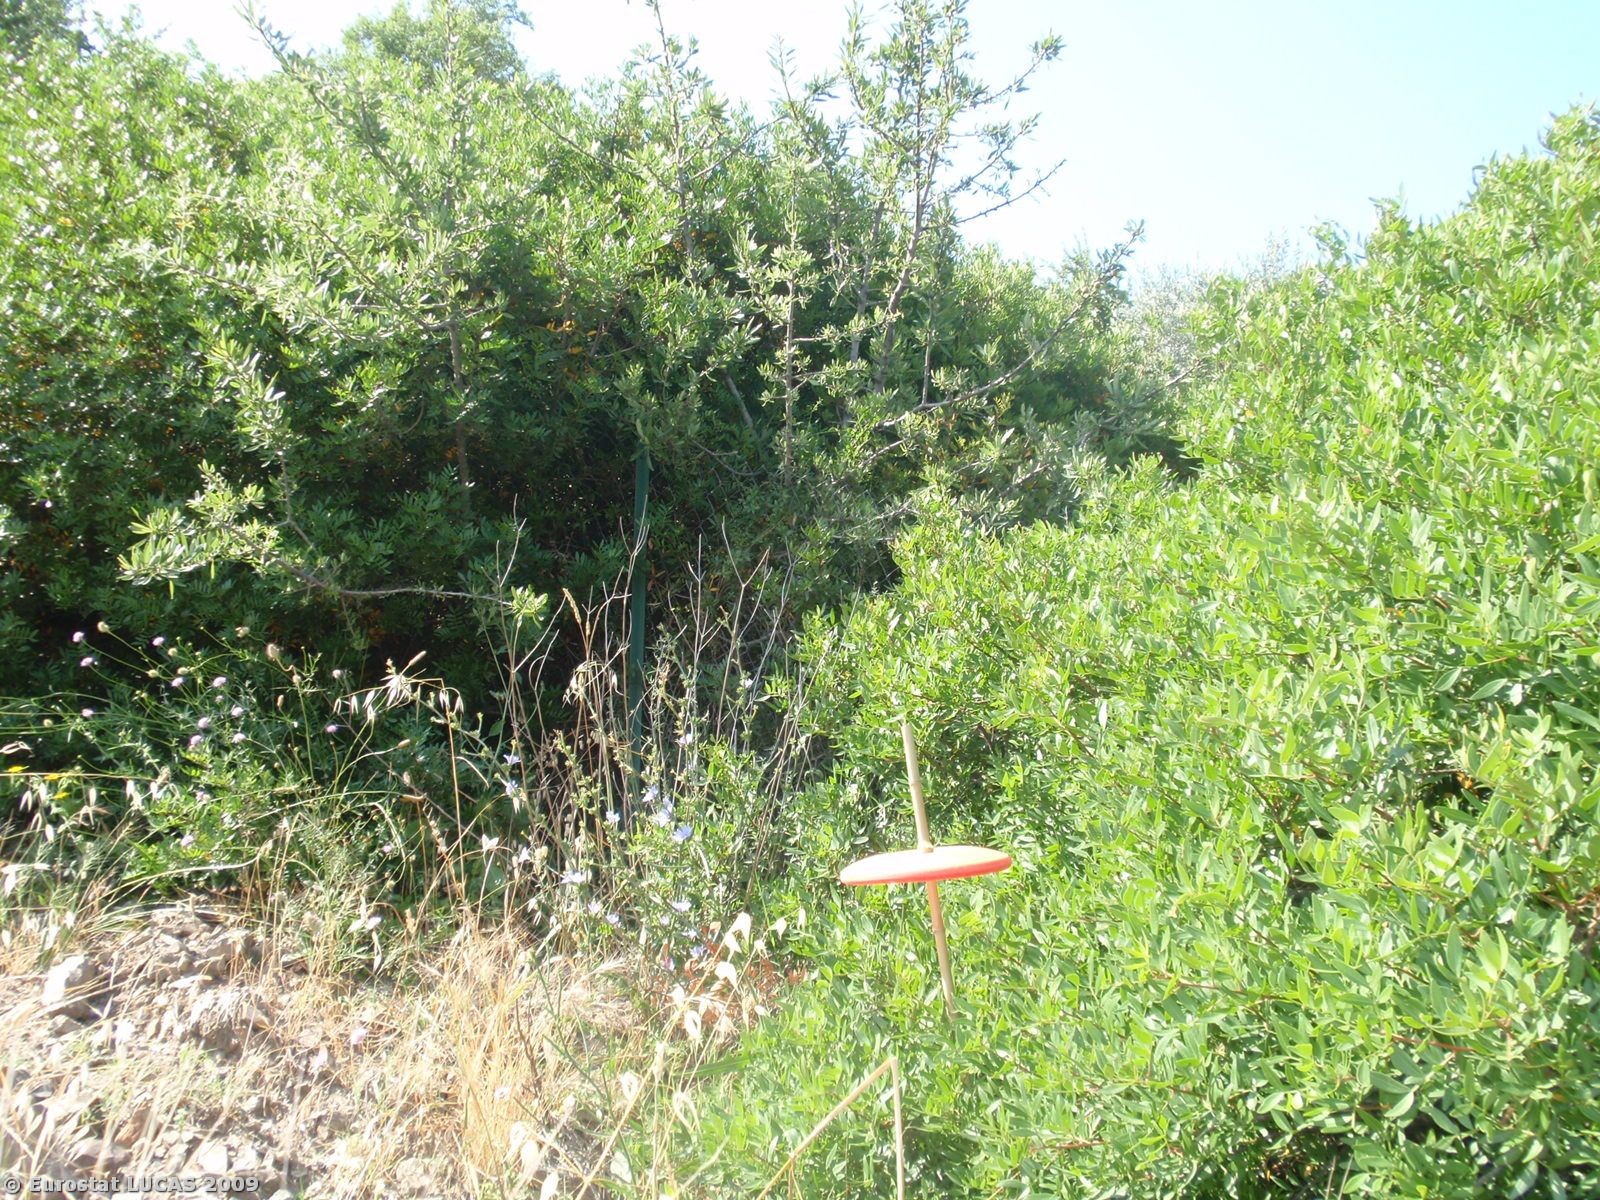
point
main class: Shrubland
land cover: Shrubland without tree cover
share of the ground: > 75 %
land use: Unused
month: June
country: IT
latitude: 40.1220
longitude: 16.5332
